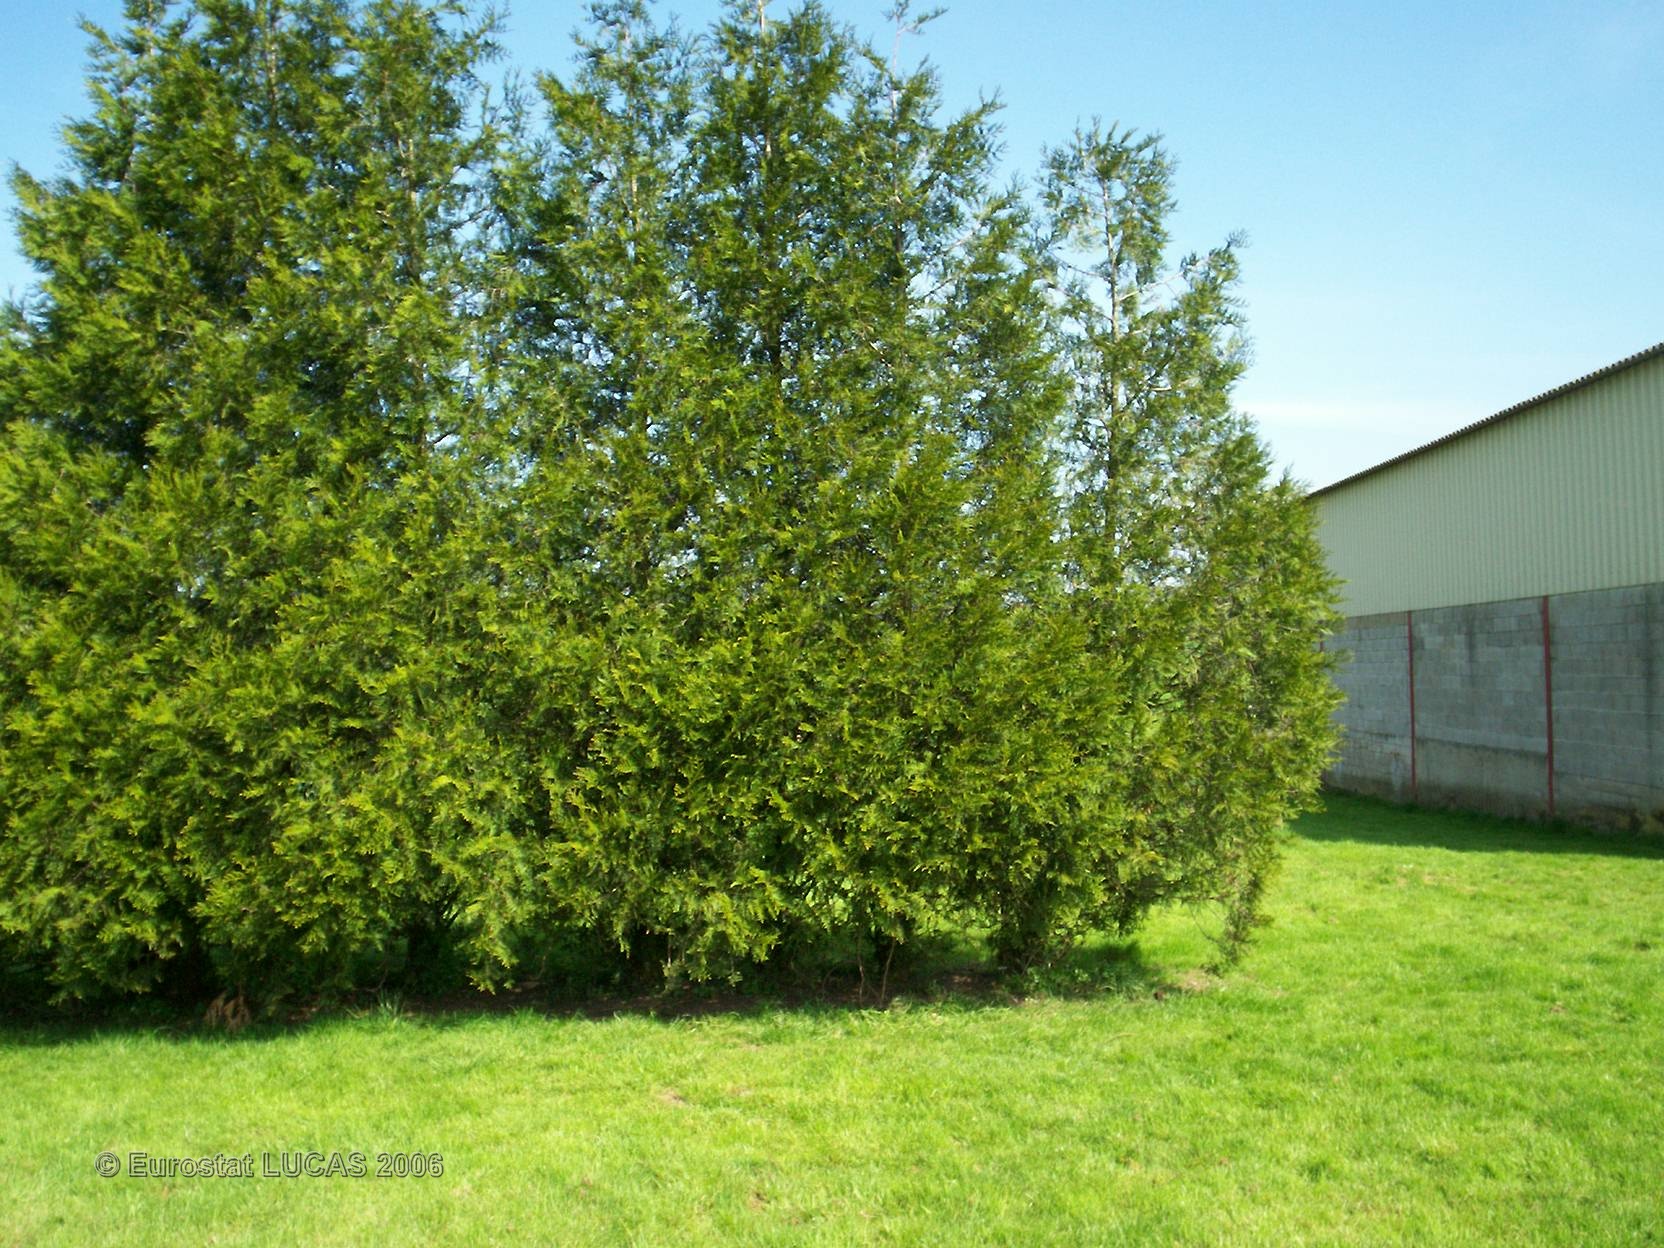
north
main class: Grassland
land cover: Grassland with sparse tree/shrub cover
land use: Residential
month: April
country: FR
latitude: 49.6328
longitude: 4.4162
